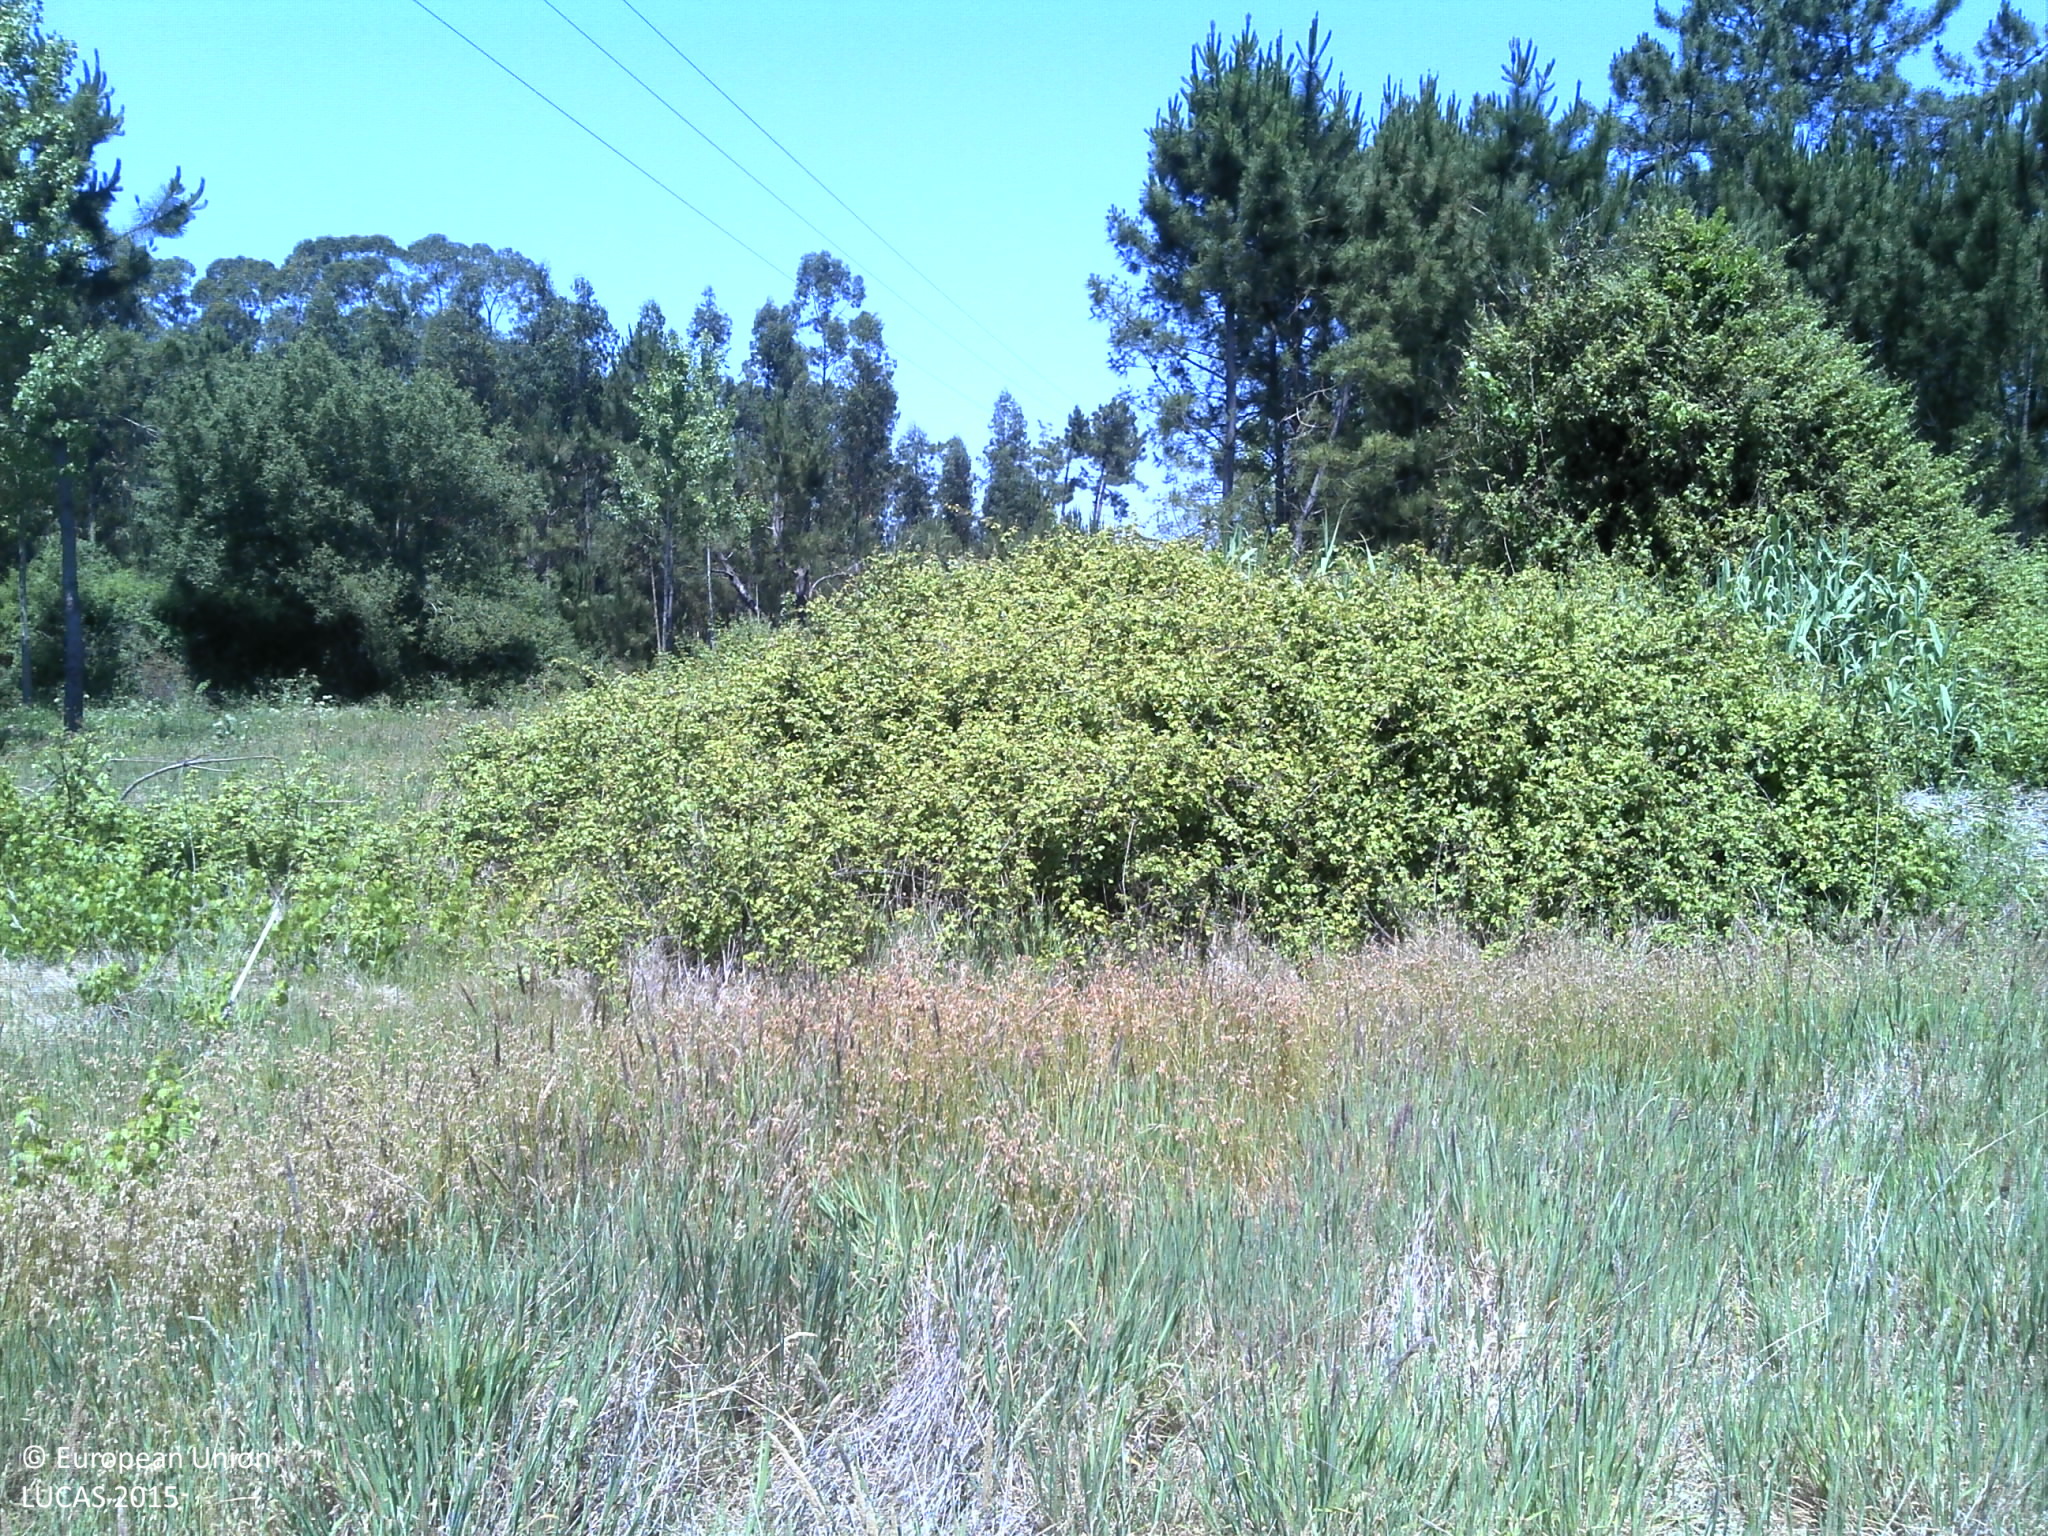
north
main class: Grassland
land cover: Grassland without tree/shrub cover
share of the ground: 50 - 75 %
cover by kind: herbaceous plants 75 %, unconsolidated bare surface 25 %
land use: Agriculture (excluding fallow land and kitchen gardens)
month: May
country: PT
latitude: 40.4432
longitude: -8.6391
